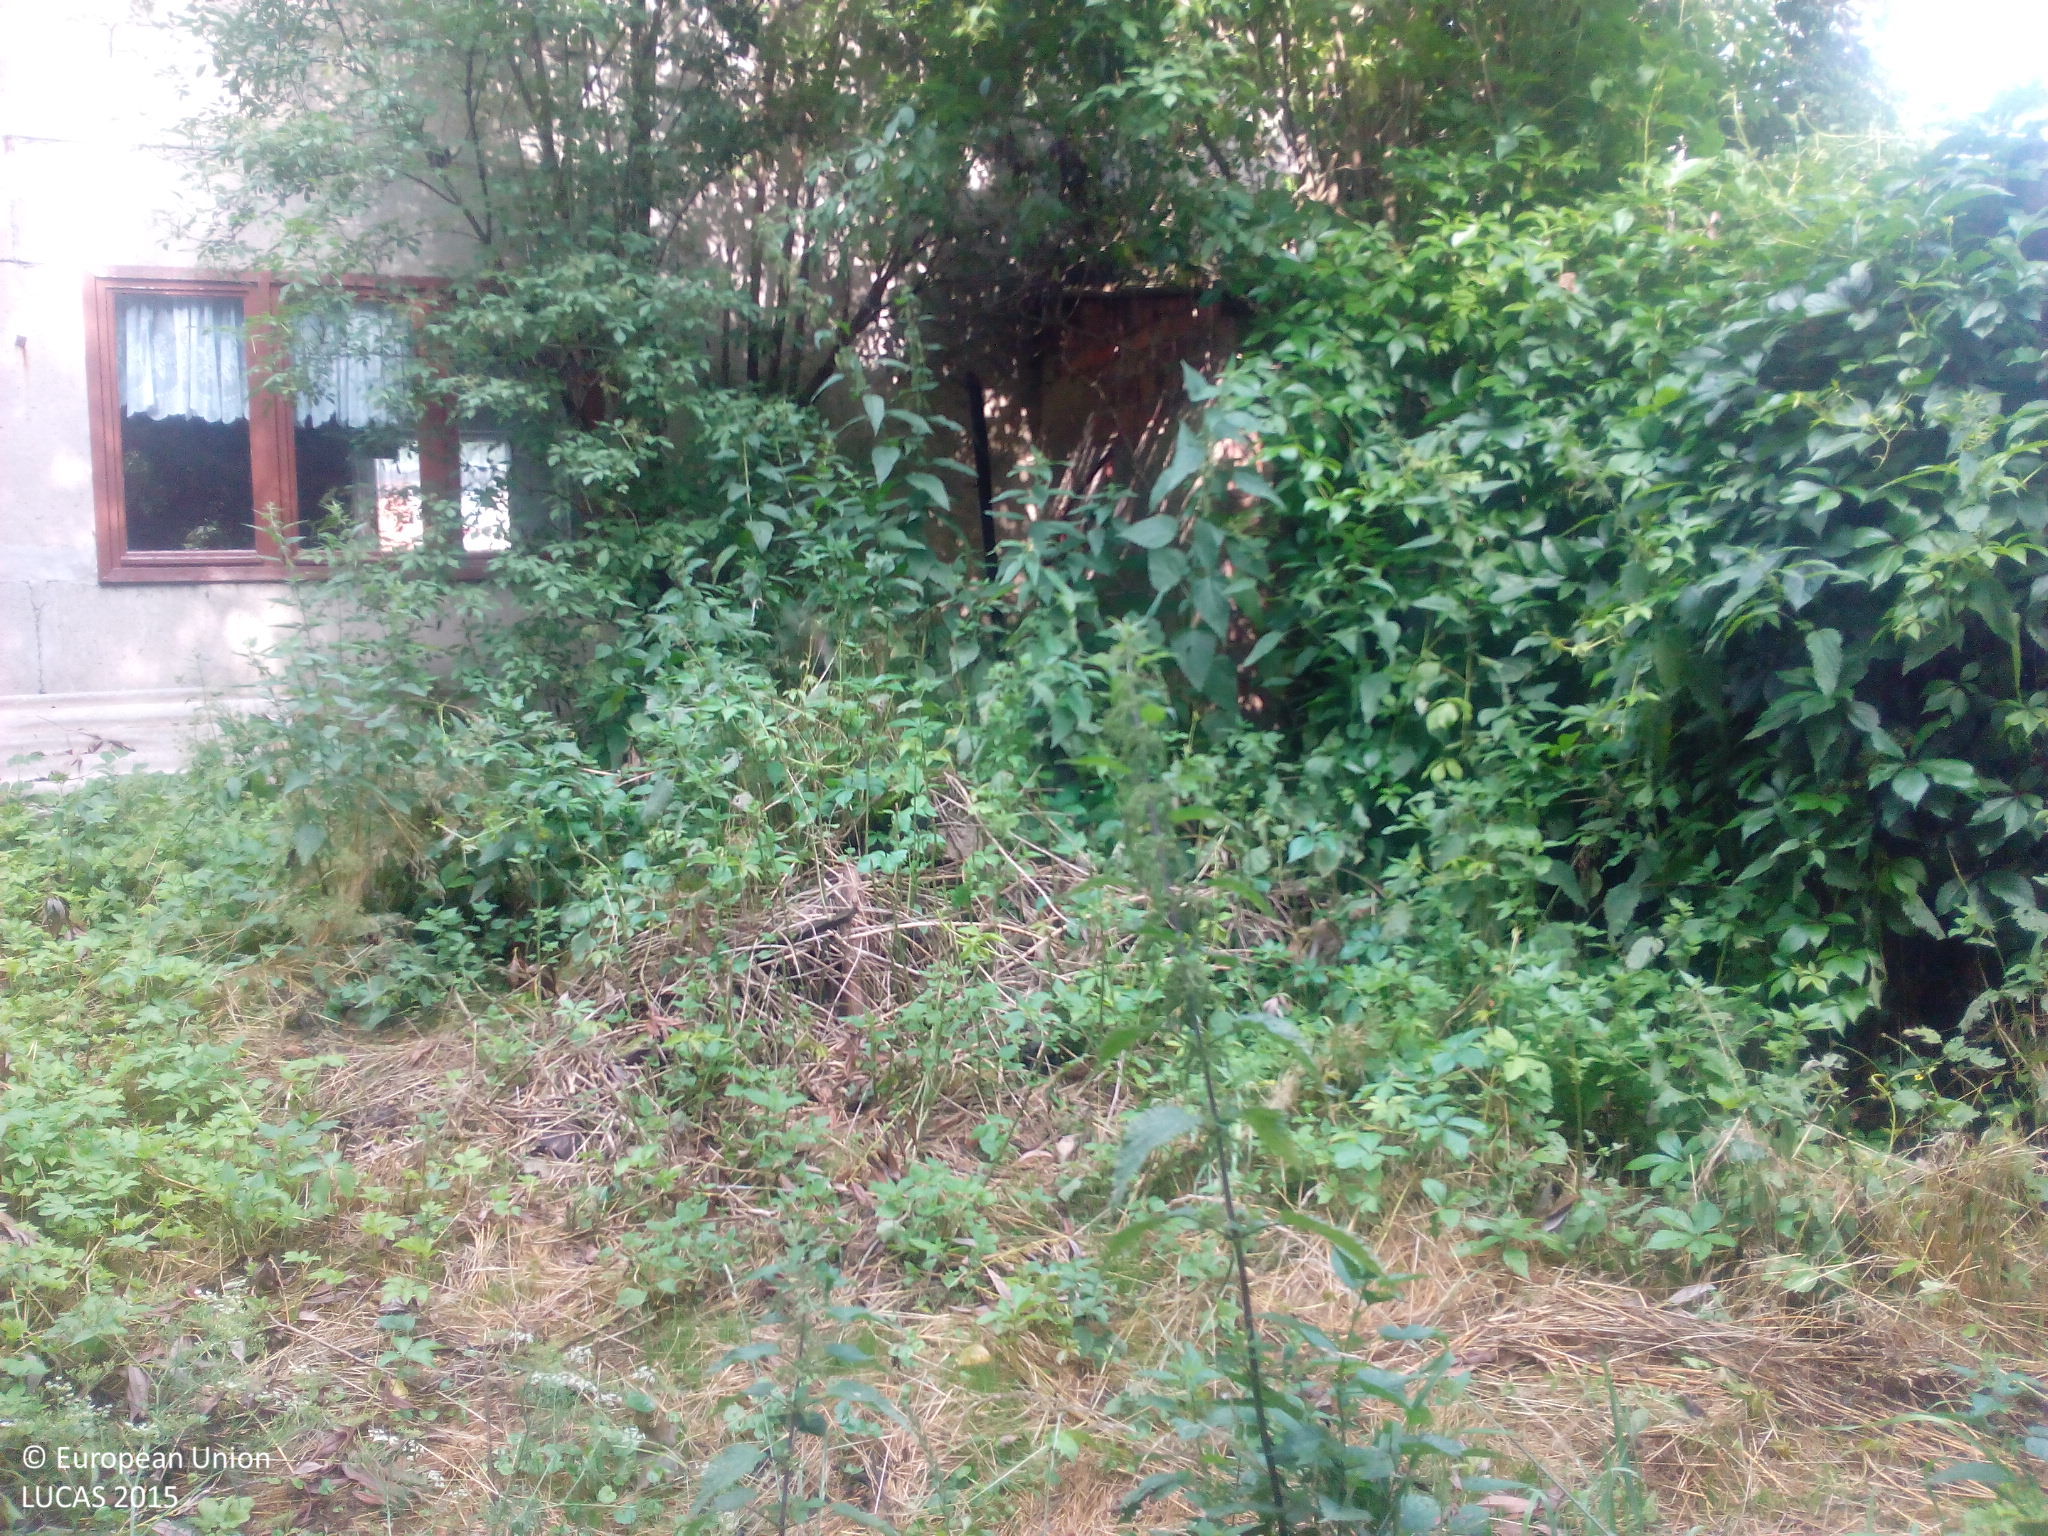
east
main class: Grassland
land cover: Grassland without tree/shrub cover
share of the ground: > 75 %
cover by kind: herbaceous plants 100 %
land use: Amenities, museums, leisure
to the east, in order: Grassland without tree/shrub cover; Broadleaved woodland; Rivers and streams; Broadleaved woodland; Spontaneously vegetated surfaces; Artificial constructions in urban areas; Grassland without tree/shrub cover; Tracks; Grassland without tree/shrub cover; Artificial constructions in urban areas; Broadleaved woodland; Ditches and canals; Broadleaved woodland; Paved roads, cycling and walking lanes; Lines of trees; Grass margins; Rape and turnip rape
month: July
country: DE
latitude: 51.7206
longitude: 11.5196
